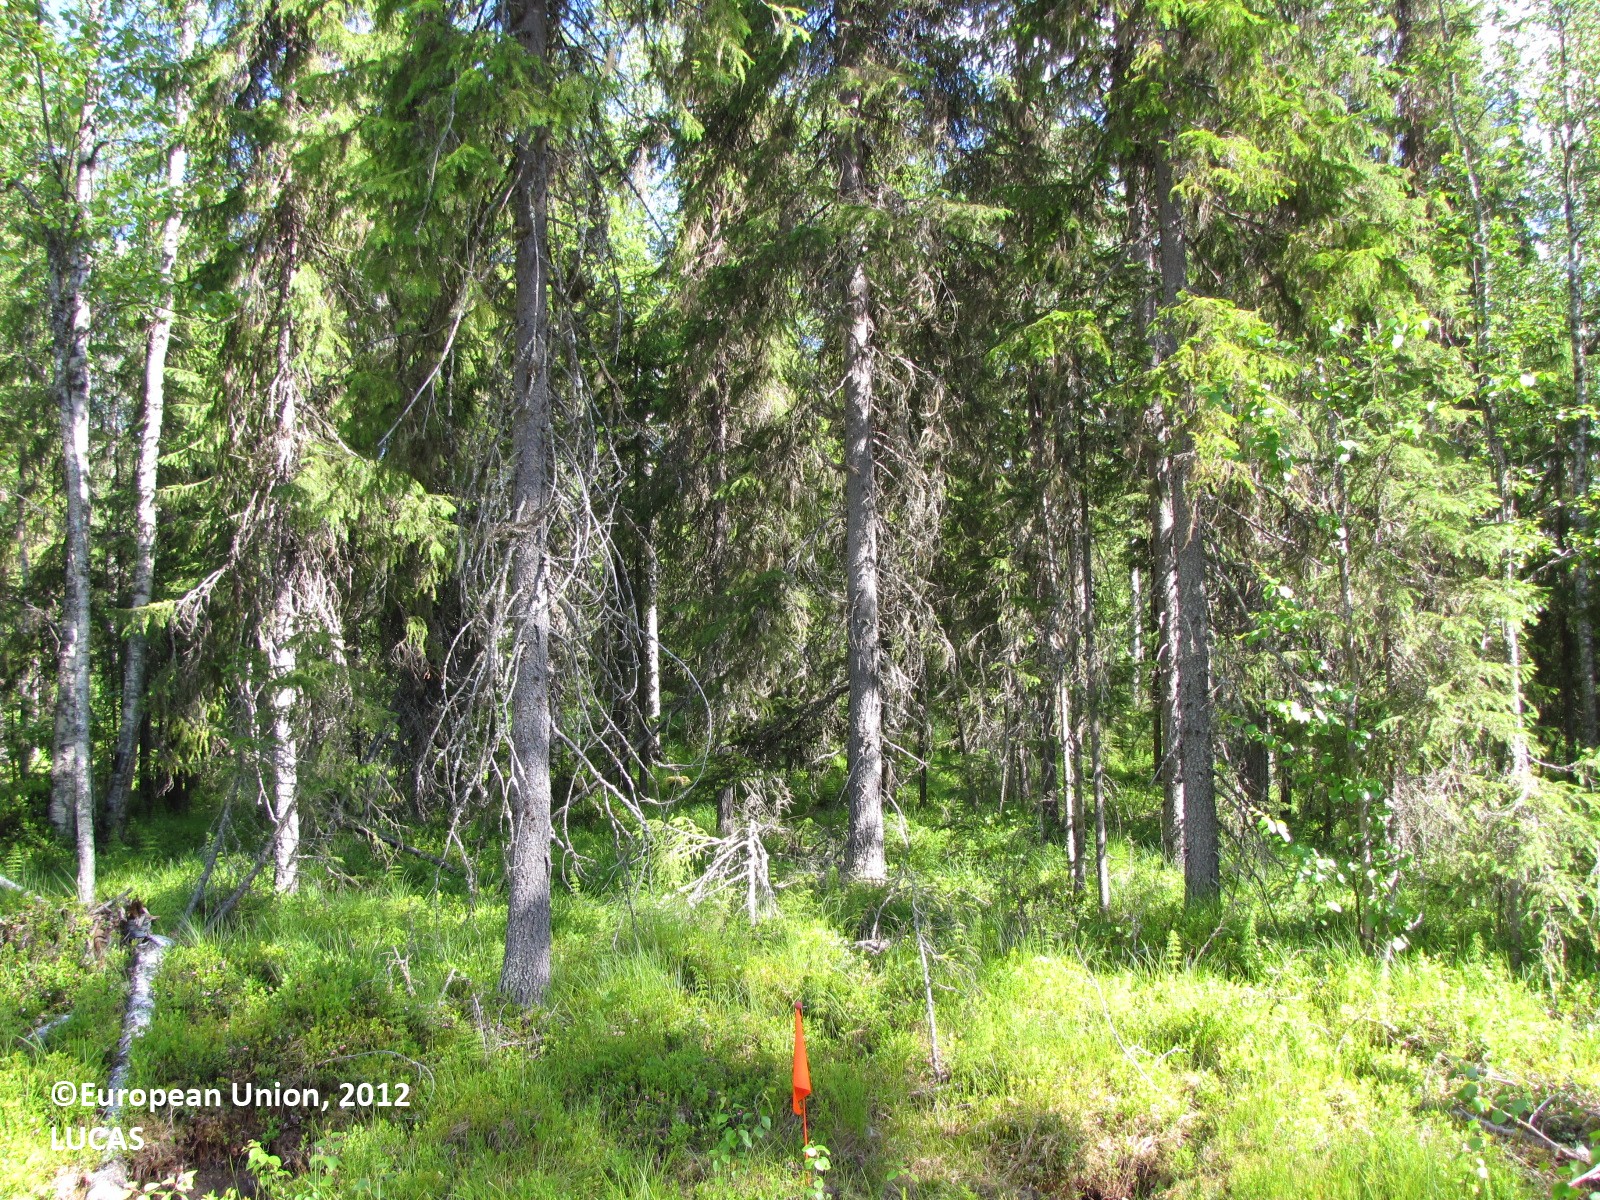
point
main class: Woodland
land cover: Spruce dominated mixed woodland
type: boreal forest
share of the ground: 25 - 50 %
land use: Forestry
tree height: > 5 m
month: July
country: FI
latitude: 66.2435
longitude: 25.2561
